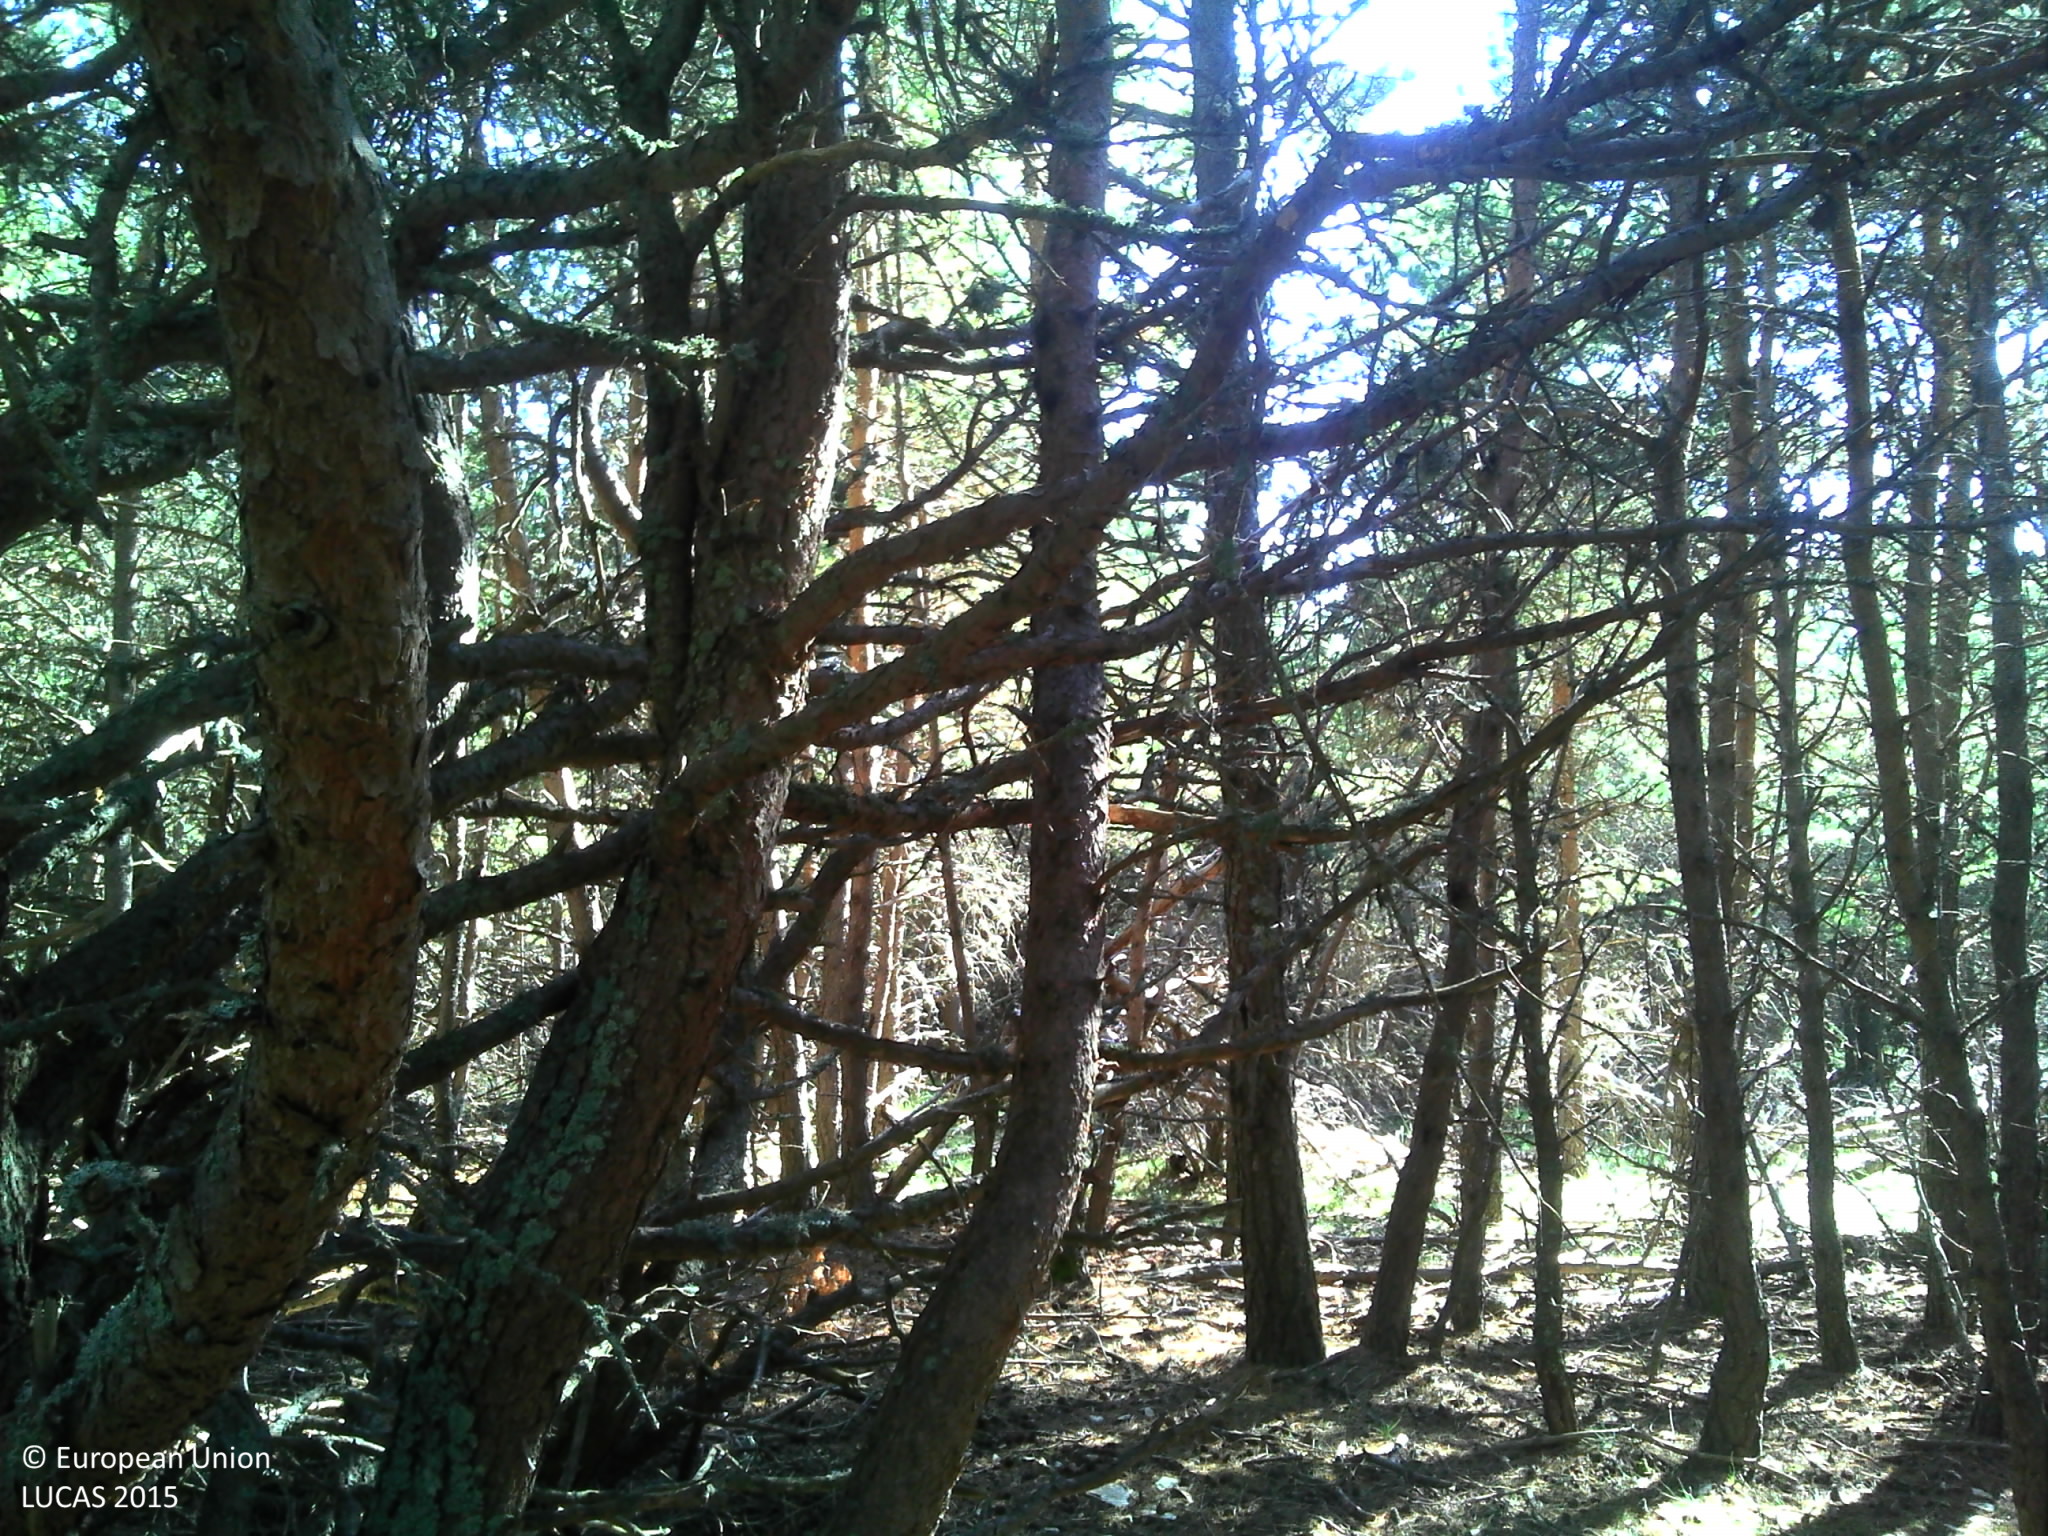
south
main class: Woodland
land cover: Pine dominated coniferous woodland
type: alpine coniferous forest
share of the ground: > 75 %
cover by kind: coniferous forest trees 80 %, herbaceous plants 15 %, broadleaved forest trees 5 %
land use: Forestry
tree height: > 5 m
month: June
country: FR
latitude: 44.1645
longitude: 5.5434
